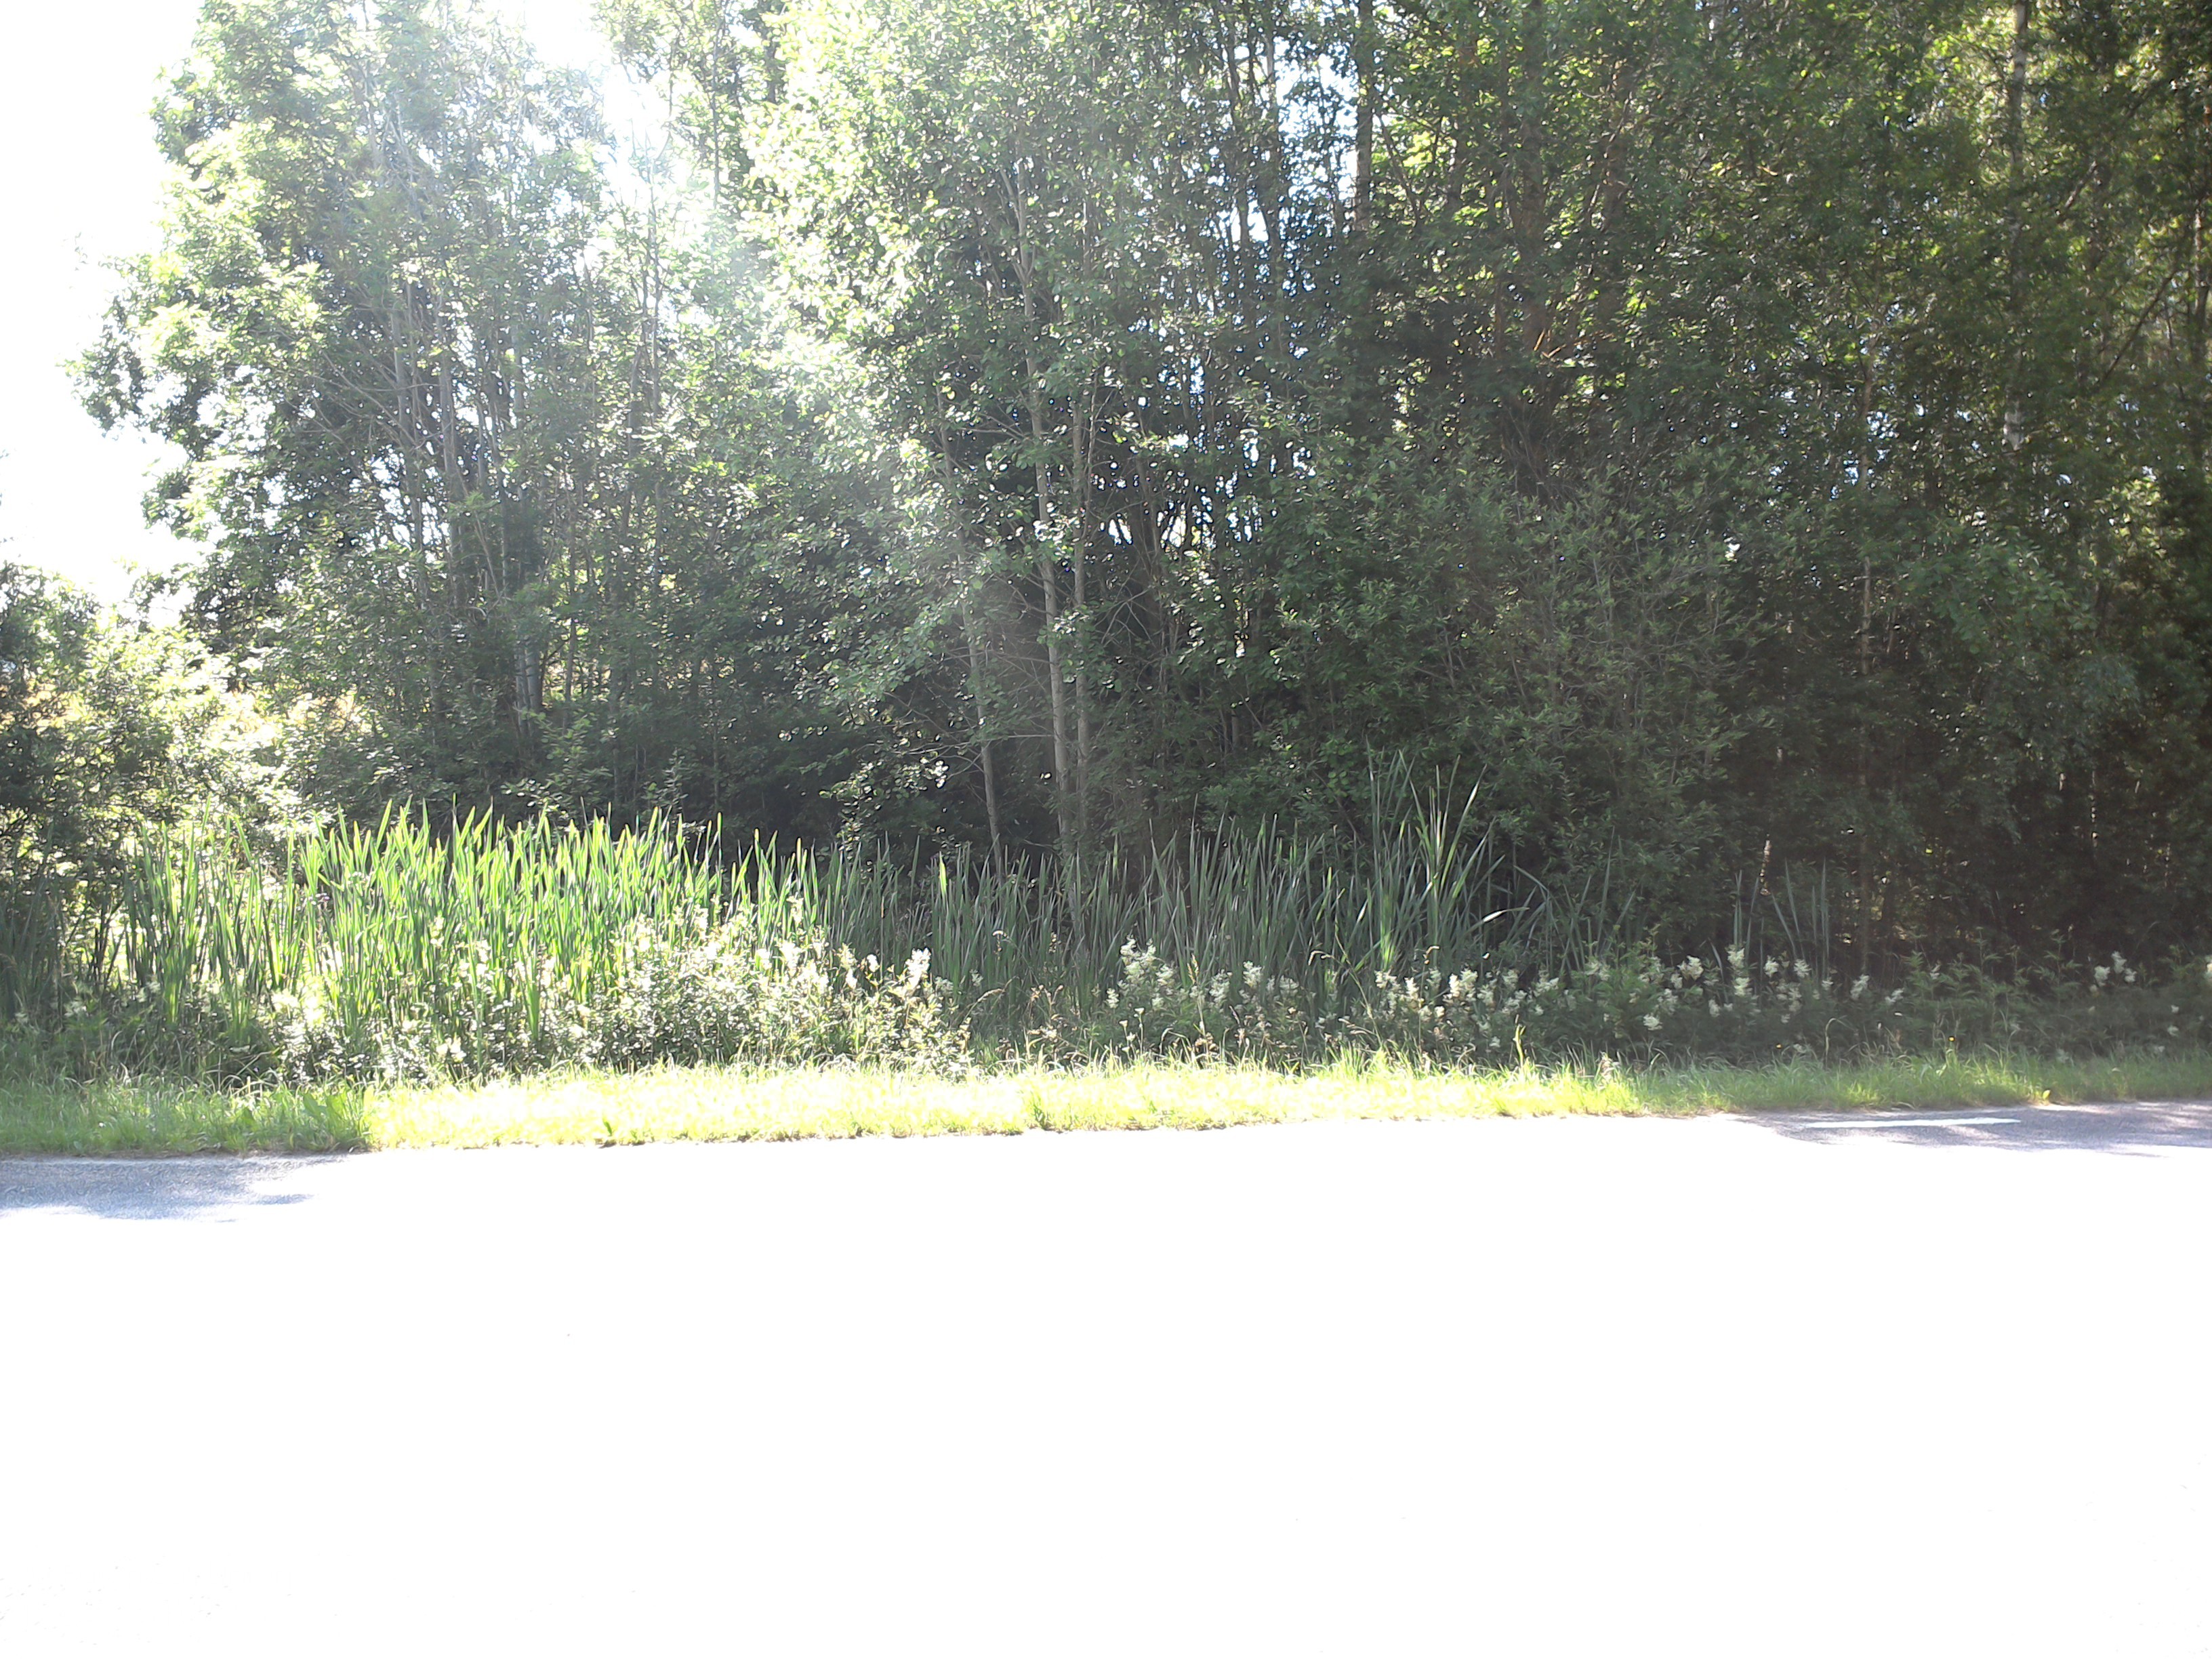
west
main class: Grassland
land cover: Grassland without tree/shrub cover
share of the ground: > 75 %
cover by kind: herbaceous plants 100 %
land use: Road transport
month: July
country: SE
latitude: 58.1362
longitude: 14.7329
